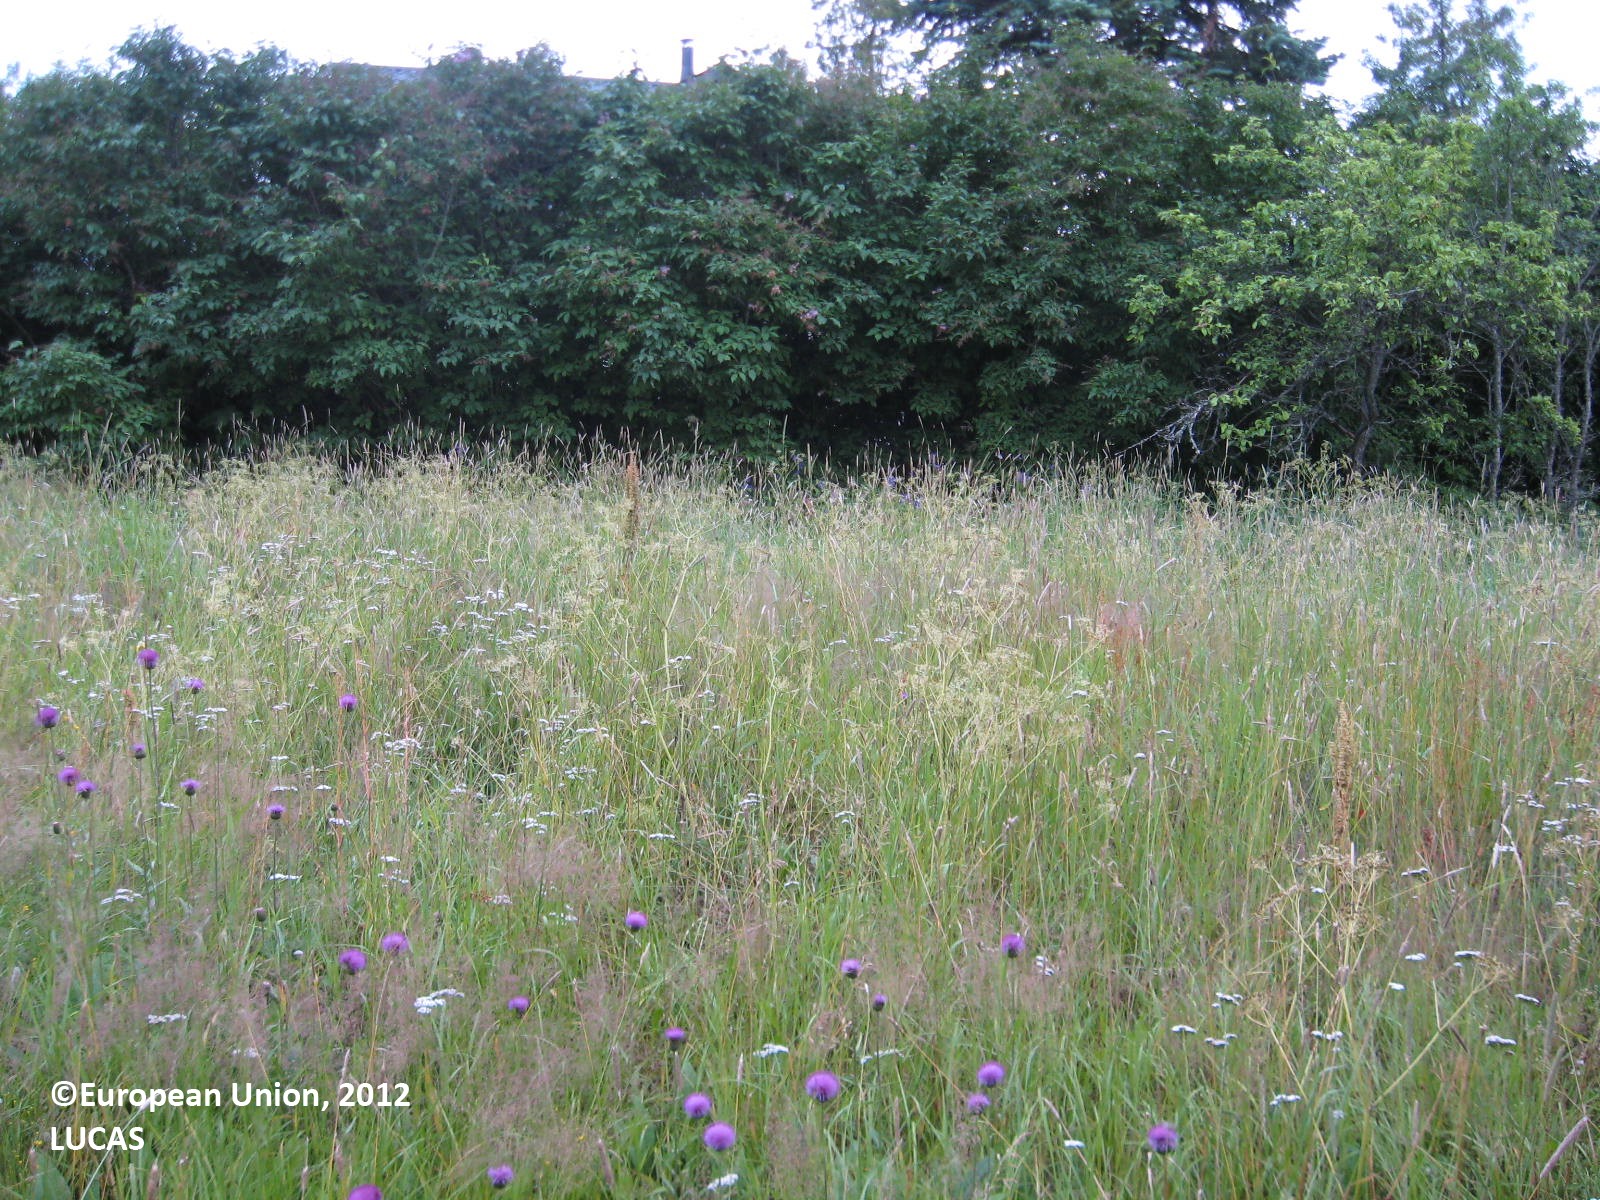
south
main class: Grassland
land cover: Grassland without tree/shrub cover
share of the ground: > 75 %
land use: Residential
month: July
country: FI
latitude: 62.5391
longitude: 21.4526
